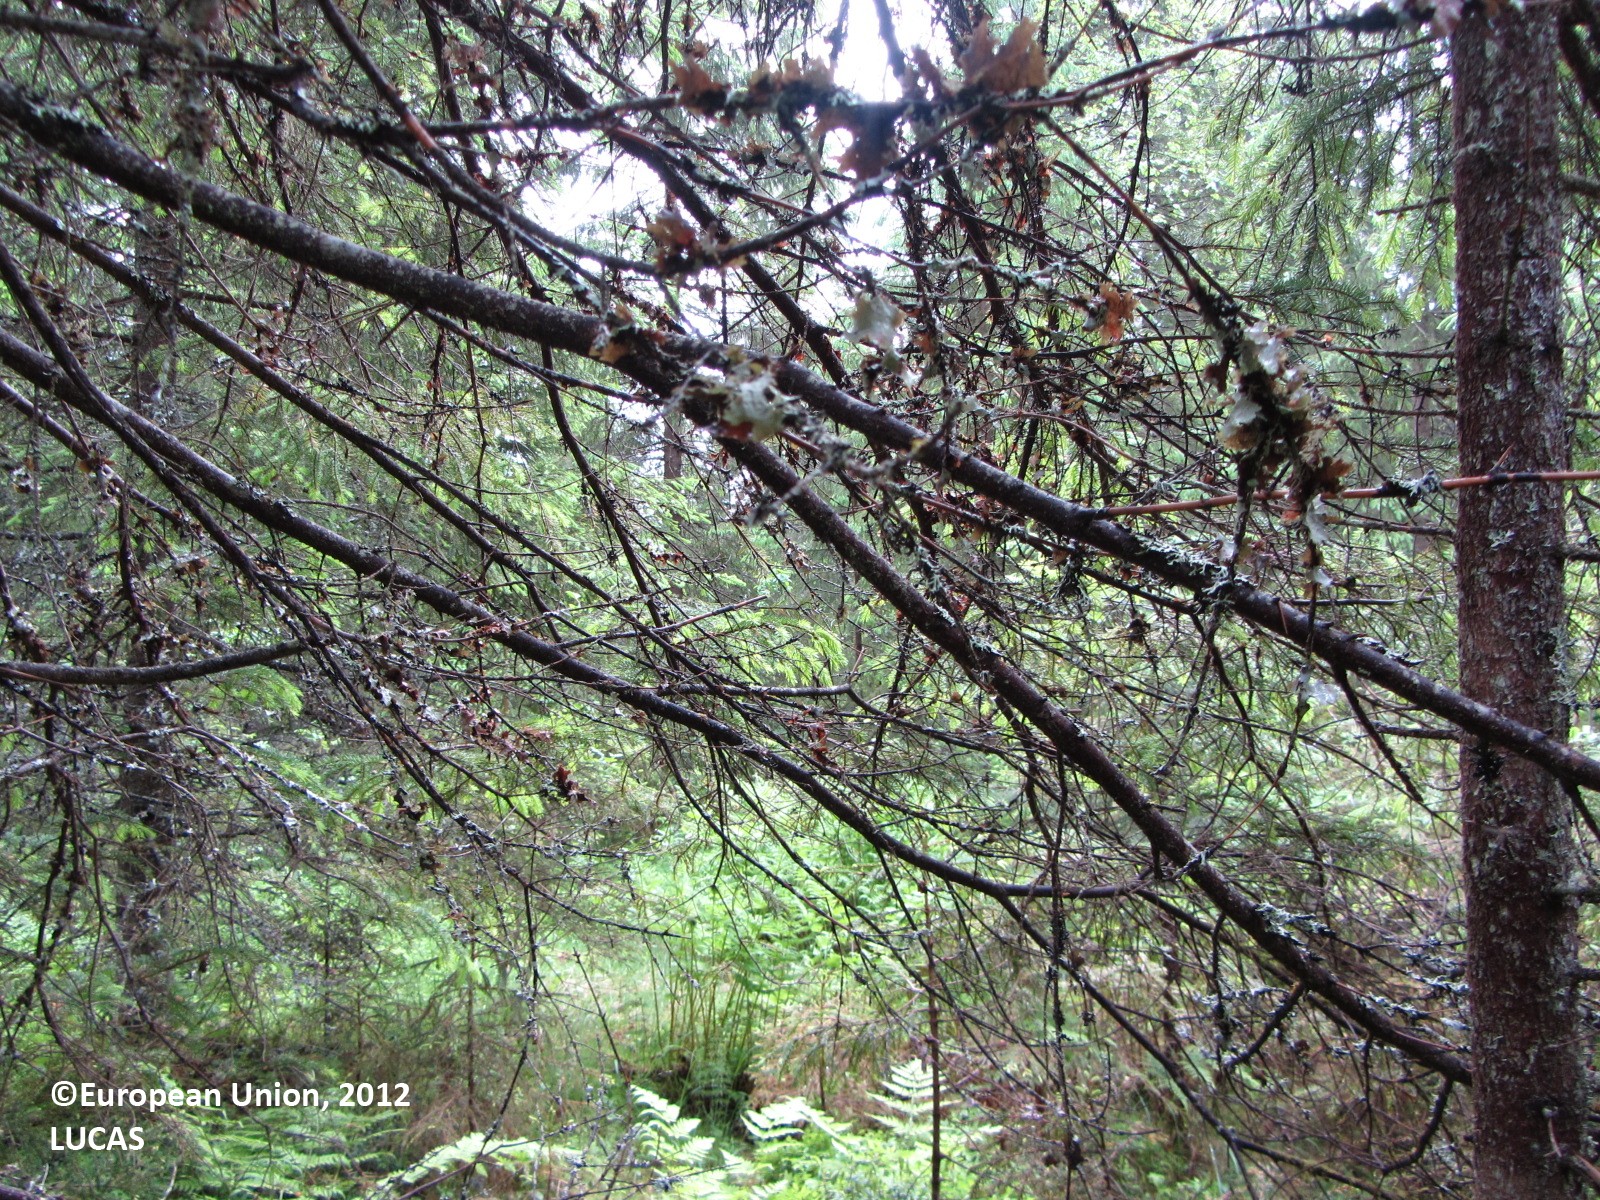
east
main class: Woodland
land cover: Spruce dominated coniferous woodland
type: boreal forest
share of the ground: > 75 %
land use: Forestry
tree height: > 5 m
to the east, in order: Spruce dominated coniferous woodland; Spruce dominated mixed woodland; Shrubland with sparse tree cover; Spruce dominated mixed woodland; Grassland with sparse tree/shrub cover; Spruce dominated mixed woodland; Shrubland with sparse tree cover; Spruce dominated mixed woodland; Tracks; Spruce dominated mixed woodland; Grassland with sparse tree/shrub cover; Tracks; Shrubland with sparse tree cover; Broadleaved woodland; Shrubland with sparse tree cover; Broadleaved woodland; Other mixed woodland
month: June
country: FI
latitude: 62.4345
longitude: 25.2739
